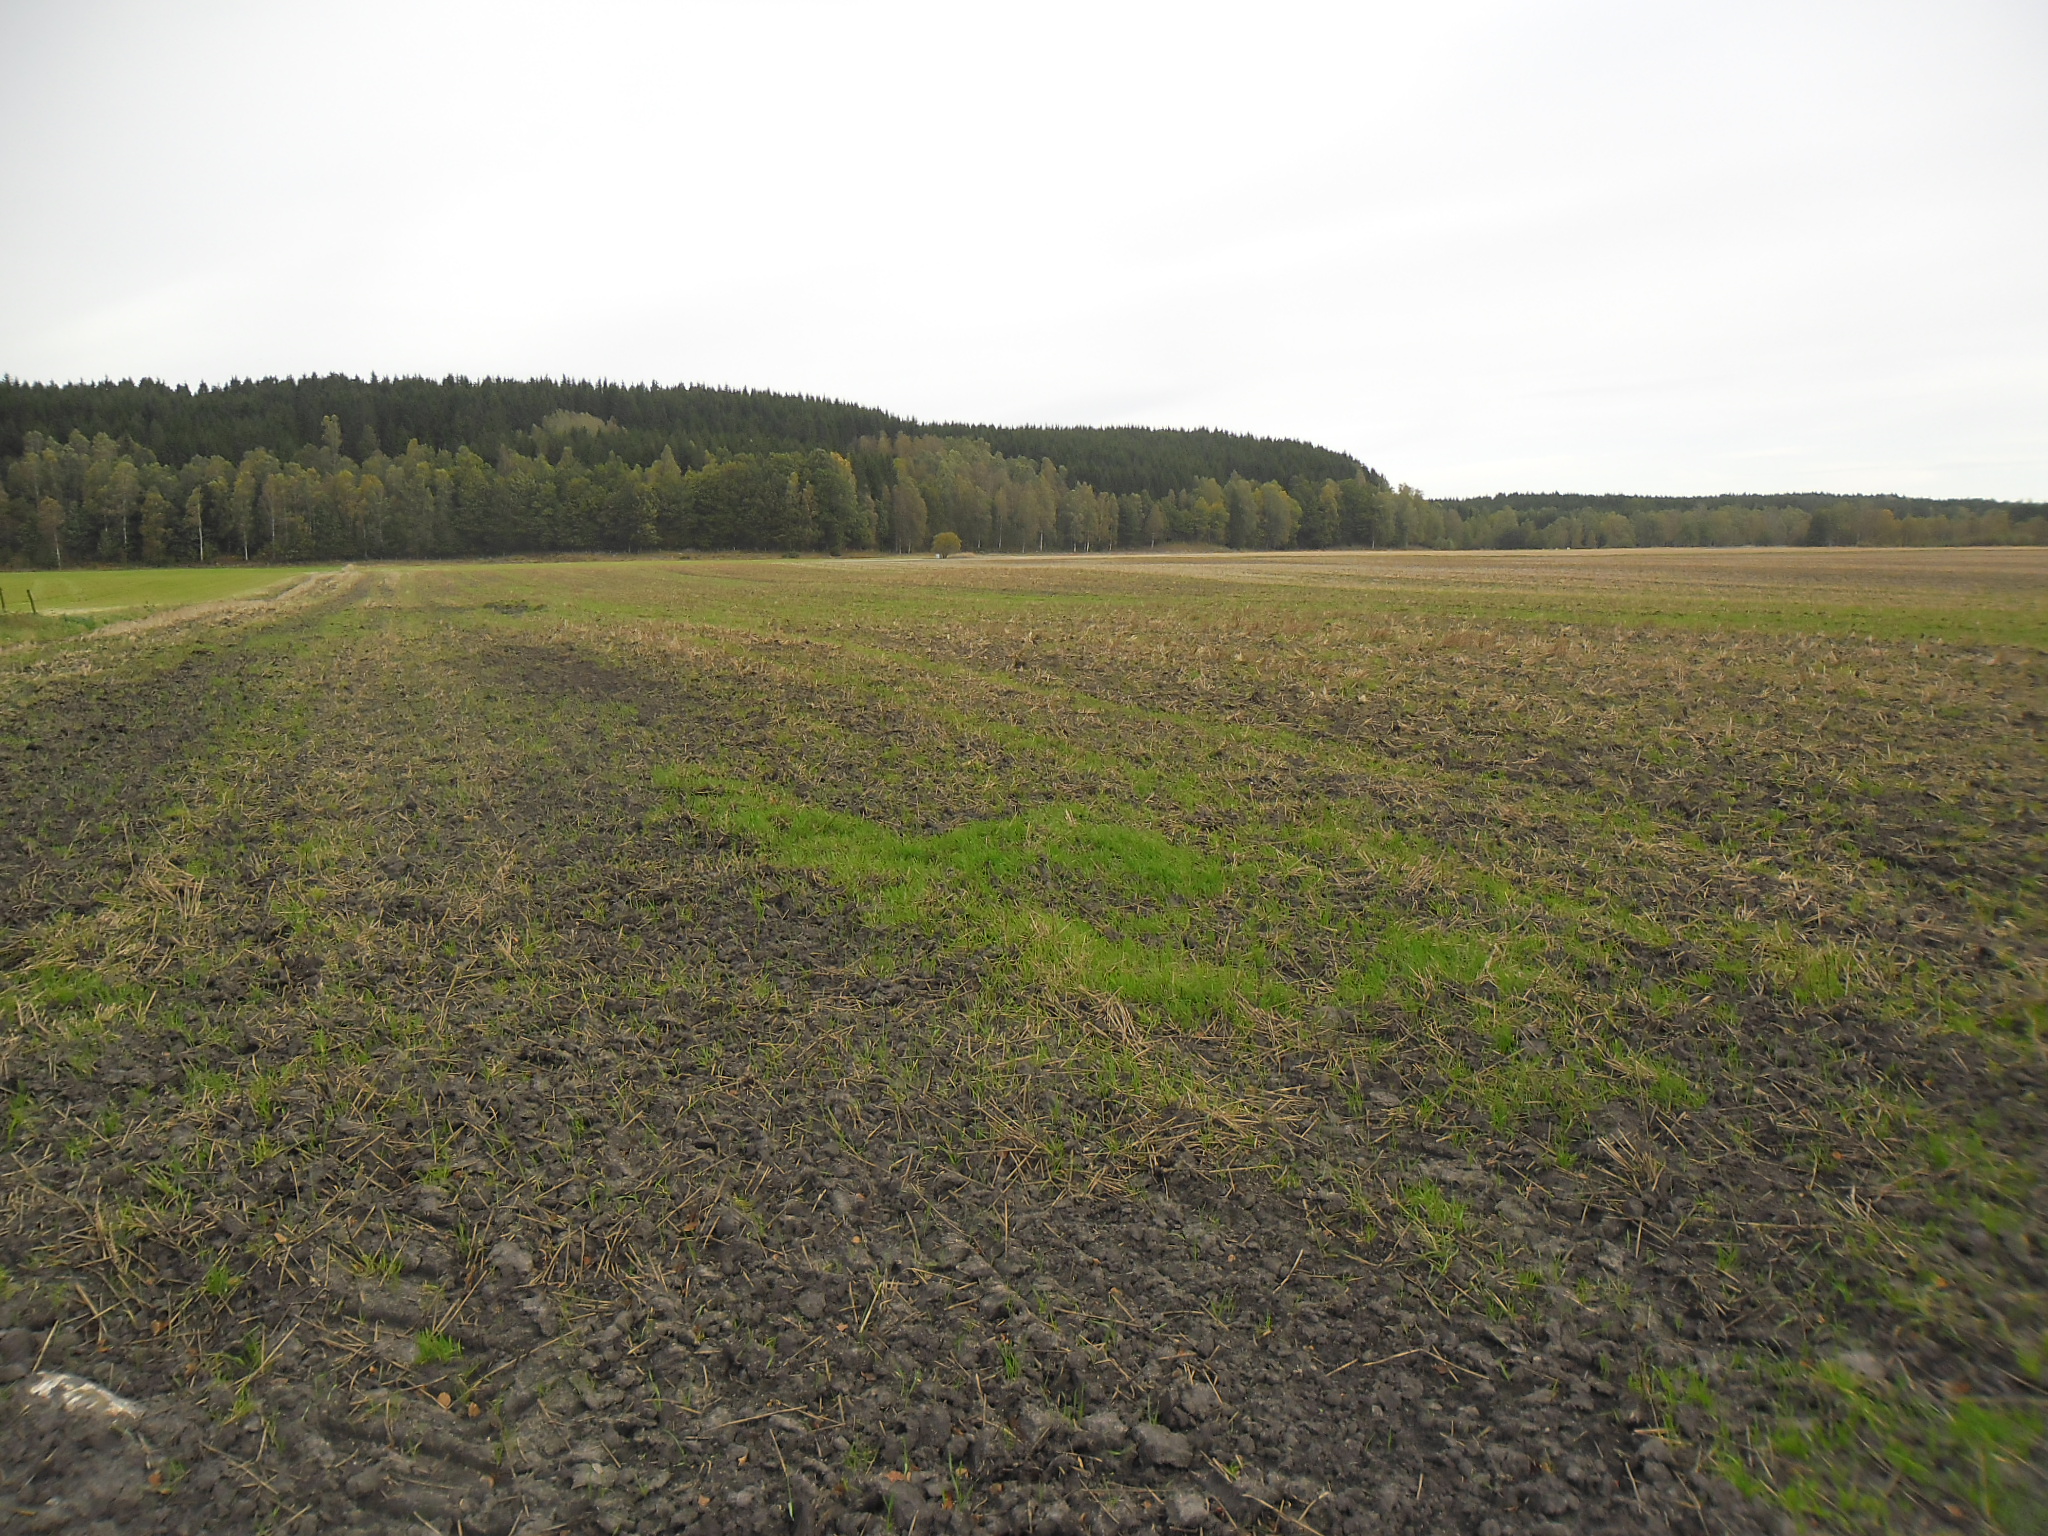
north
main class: Cropland
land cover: Common wheat
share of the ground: < 10 %
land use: Agriculture (excluding fallow land and kitchen gardens)
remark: Harvested field
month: October
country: SE
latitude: 56.5445
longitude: 13.1685
